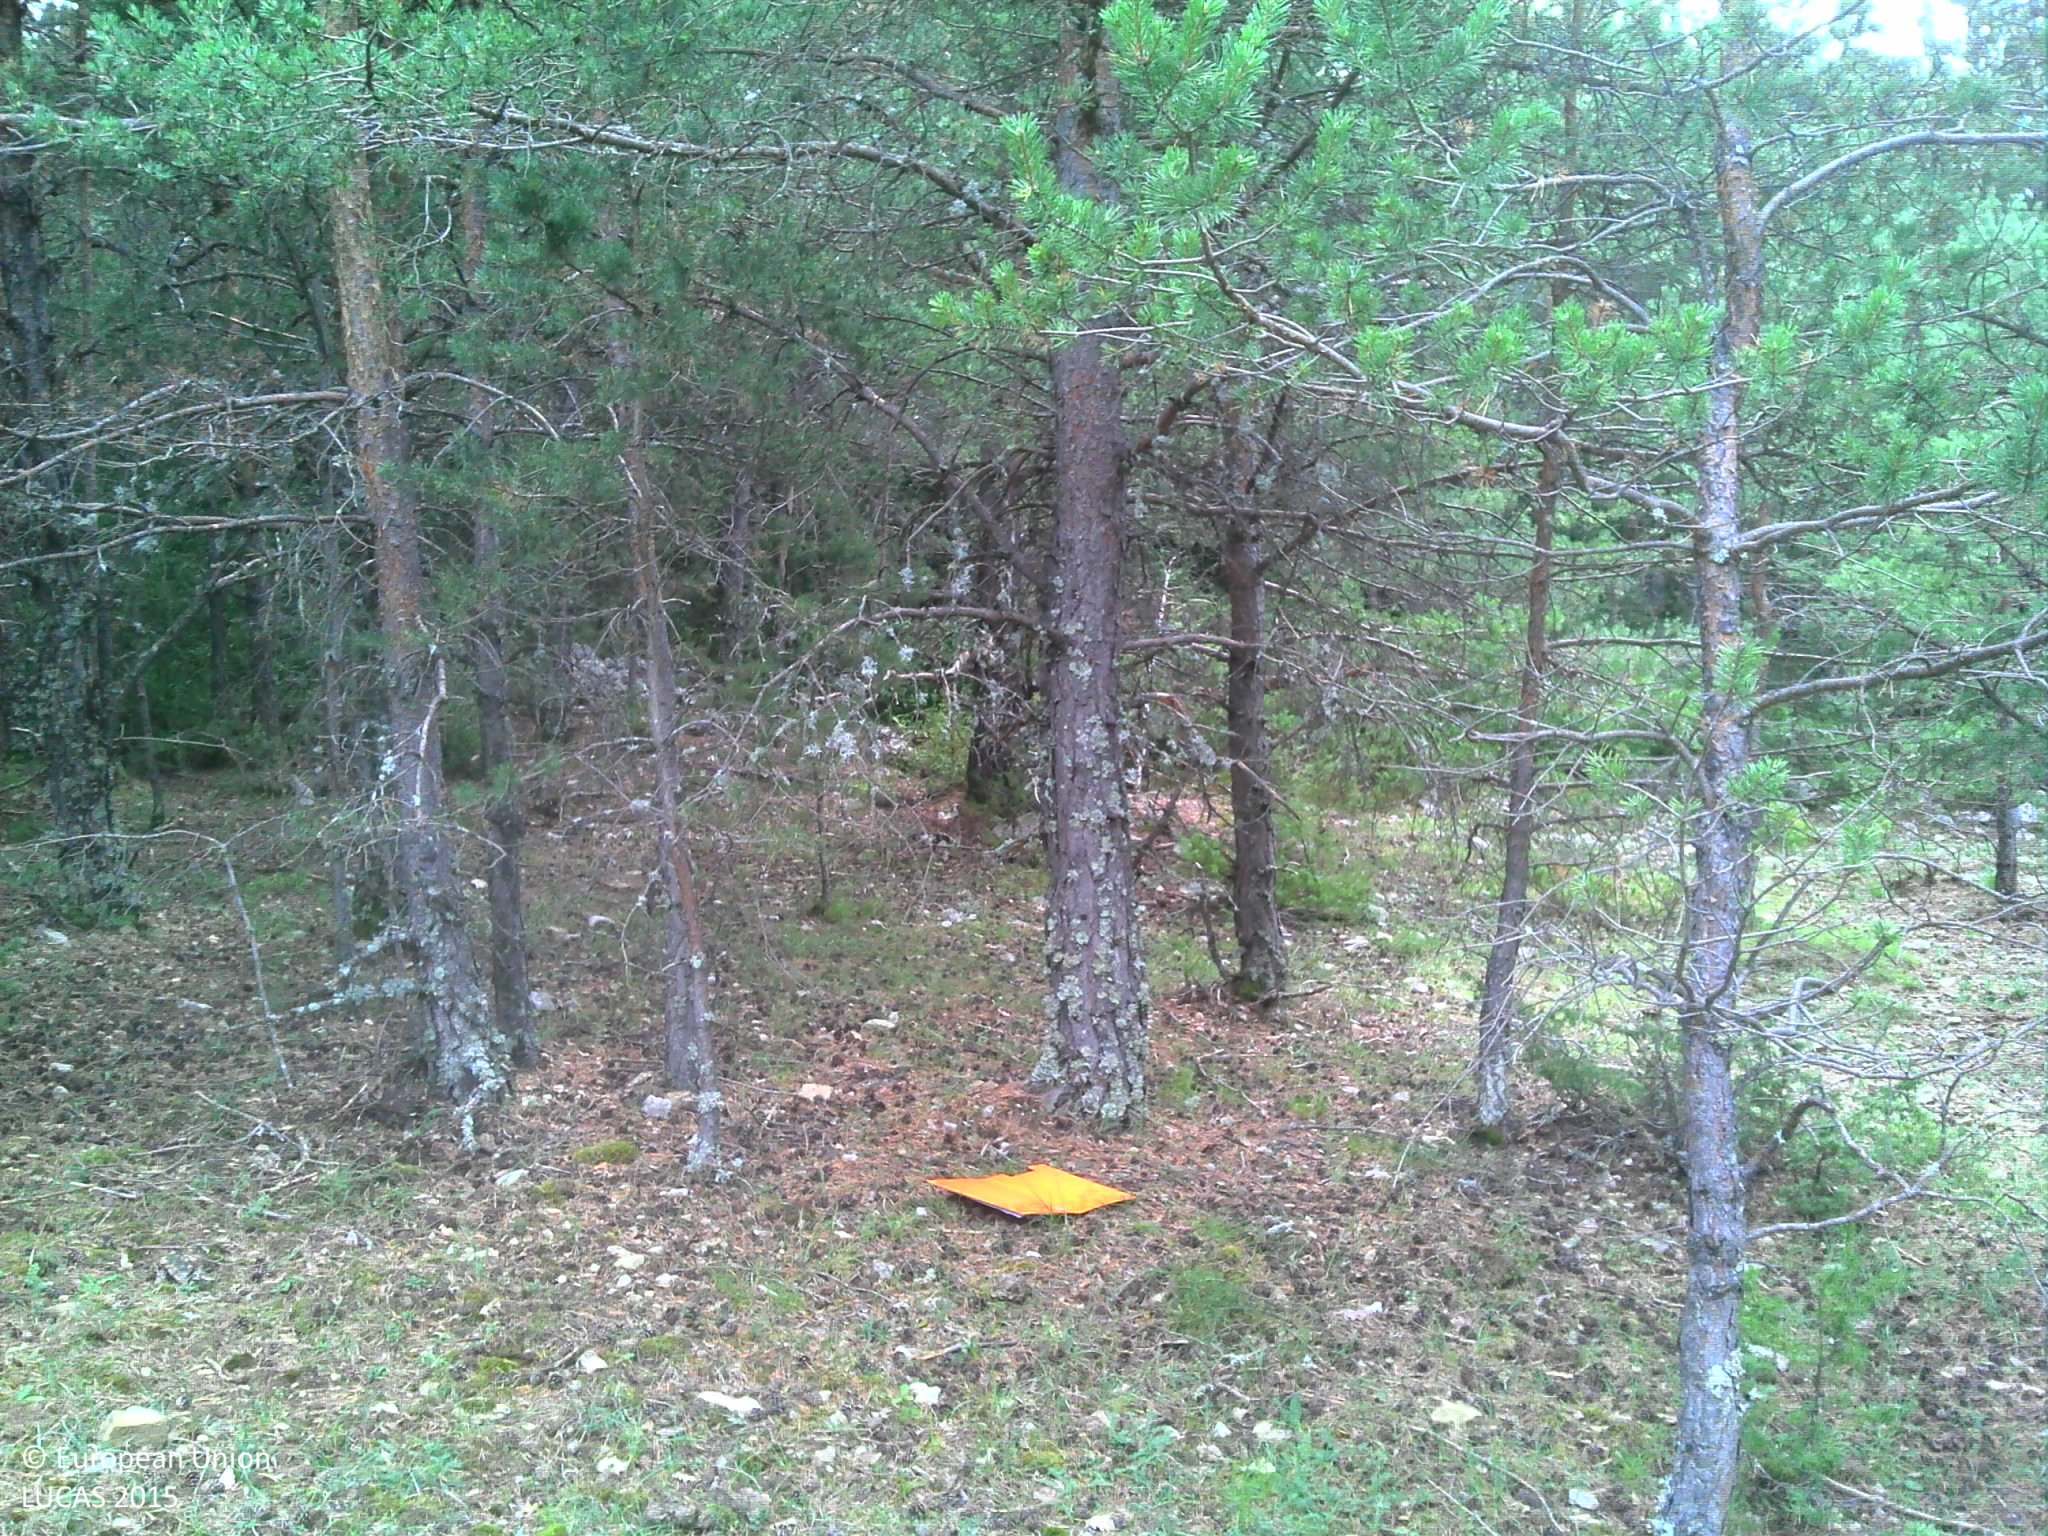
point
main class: Woodland
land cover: Pine dominated coniferous woodland
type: alpine coniferous forest
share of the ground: 50 - 75 %
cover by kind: coniferous forest trees 90 %, consolidated bare surface 10 %
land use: Semi-natural and natural areas not in use
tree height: > 5 m
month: August
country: FR
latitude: 44.0679
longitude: 6.2994
